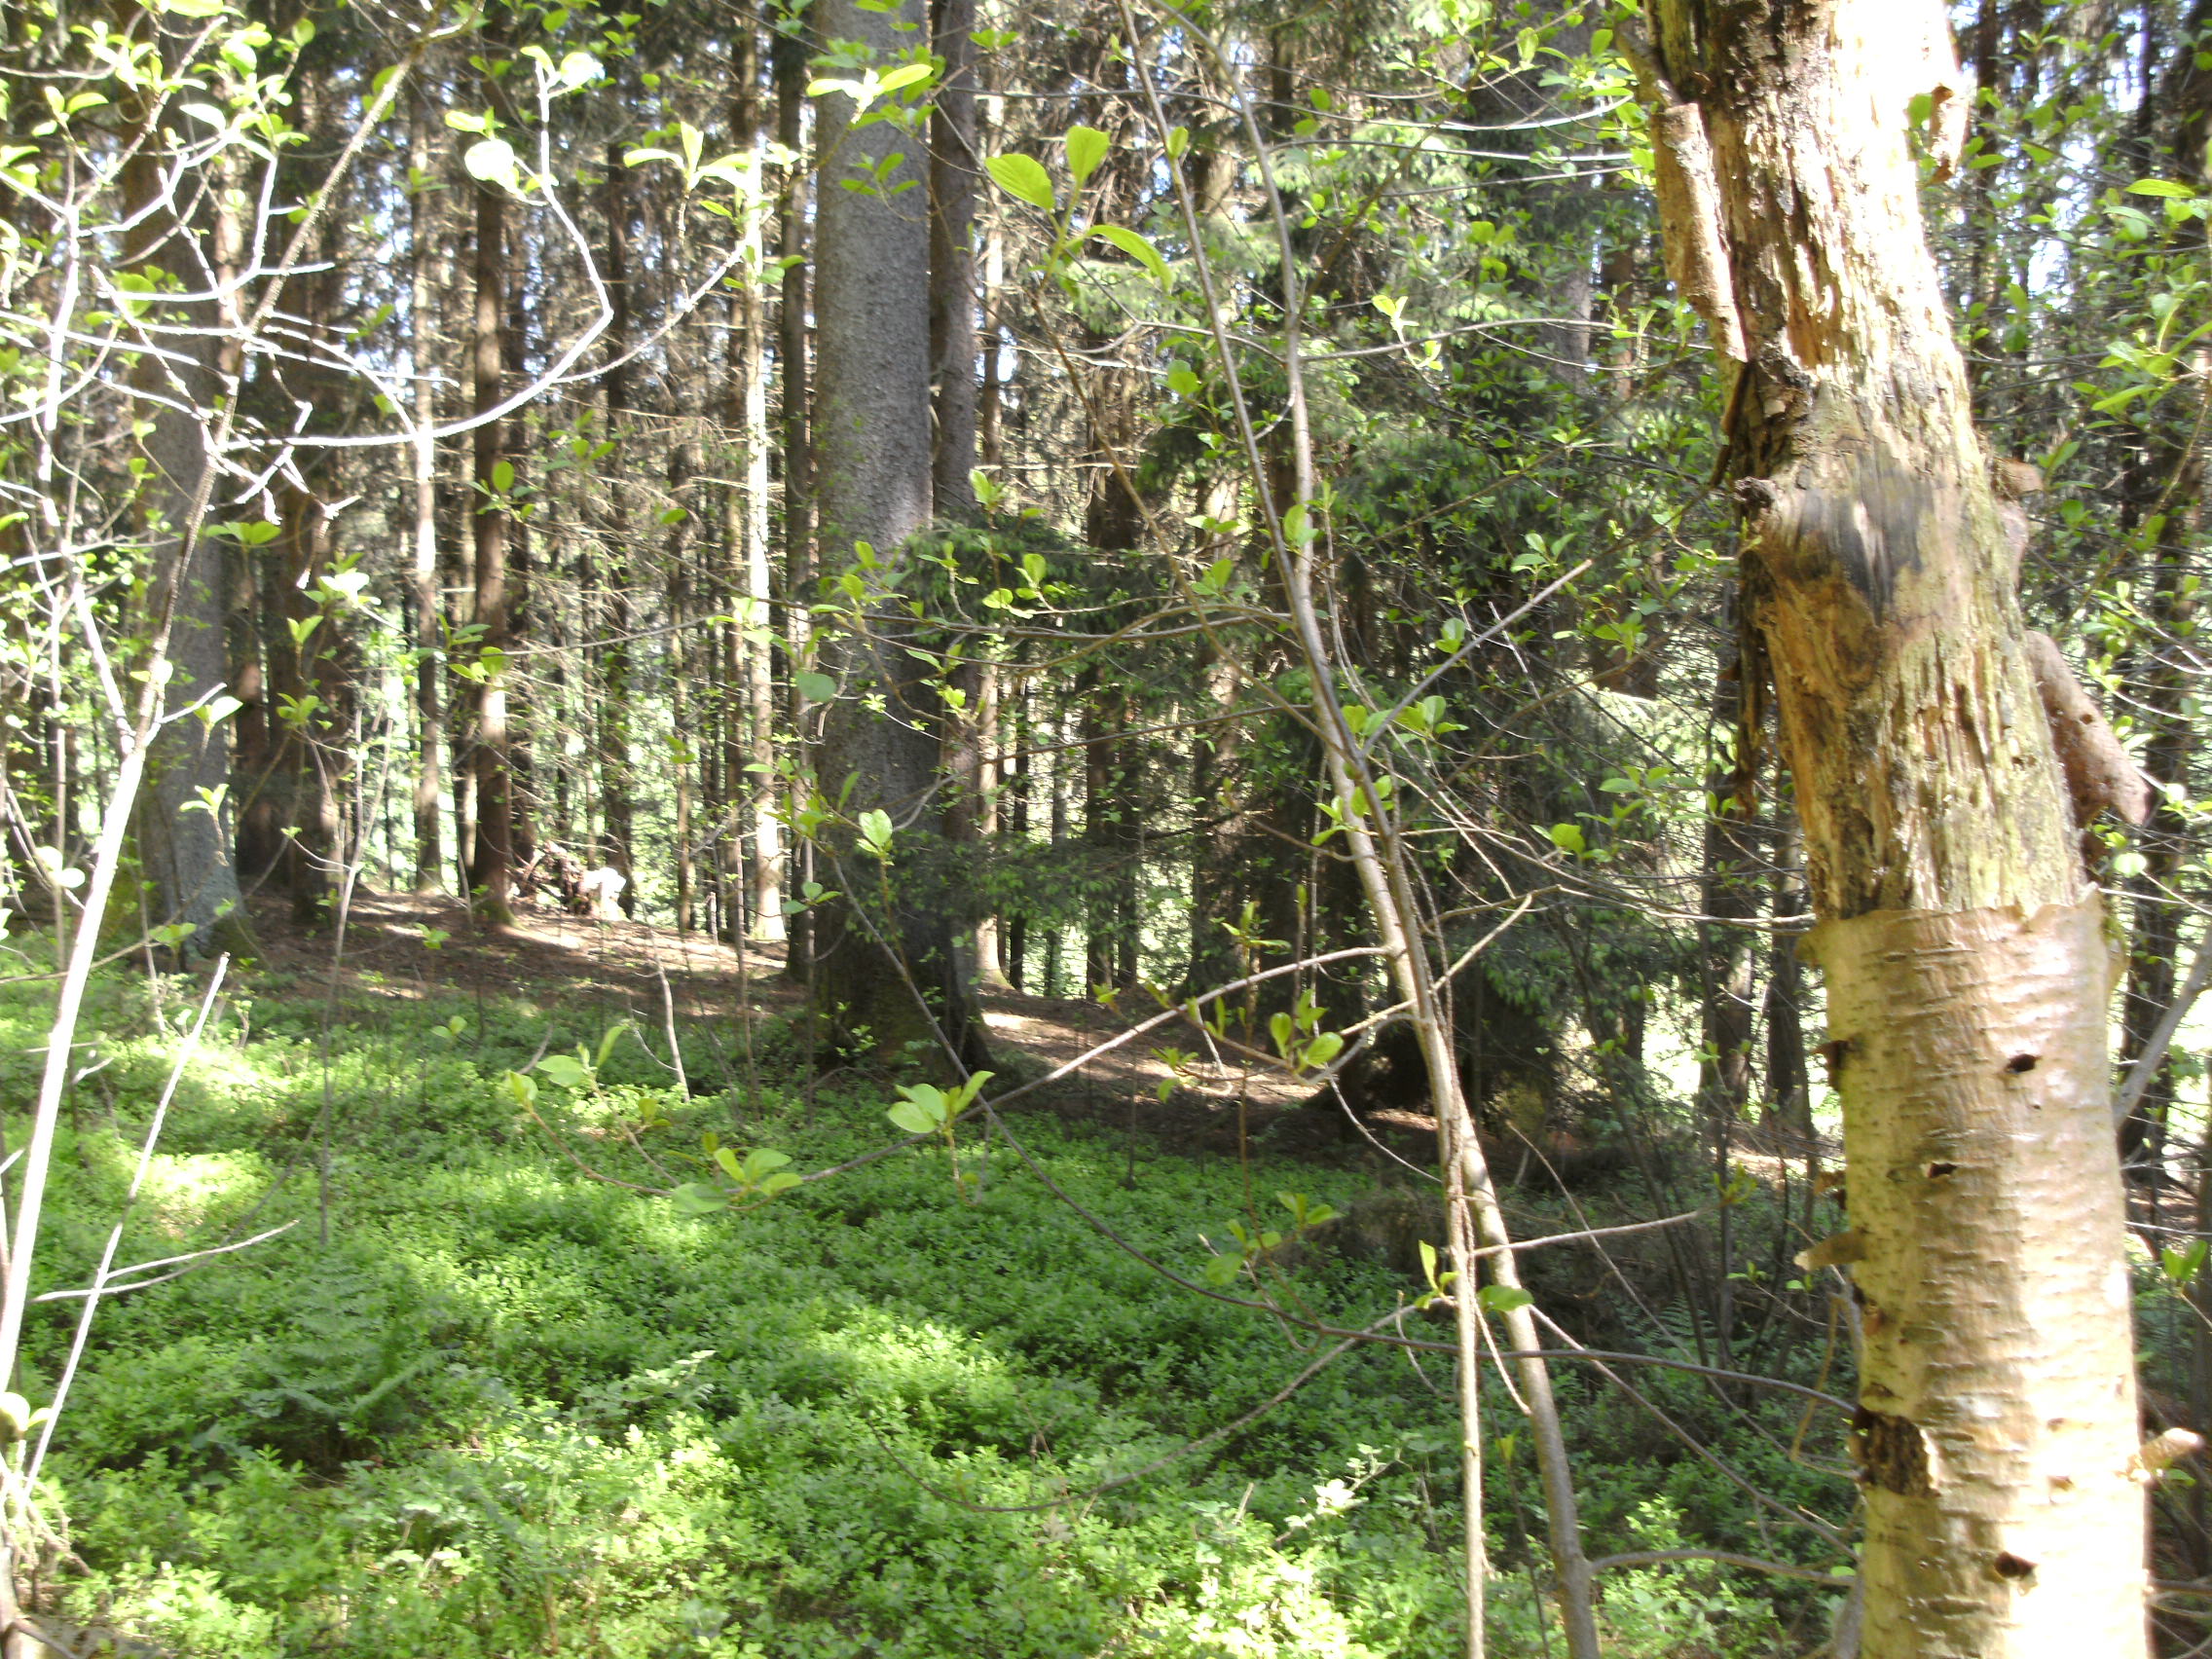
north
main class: Woodland
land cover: Spruce dominated mixed woodland
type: hemiboreal forest and nemoral coniferous forest and mixed broadleaved-coniferous forest
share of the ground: > 75 %
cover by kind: coniferous forest trees 45 %, broadleaved forest trees 45 %, shrubs 10 %
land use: Forestry
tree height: > 5 m
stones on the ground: 25 - 50 %
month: May
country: AT
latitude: 48.5092
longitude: 13.5325
